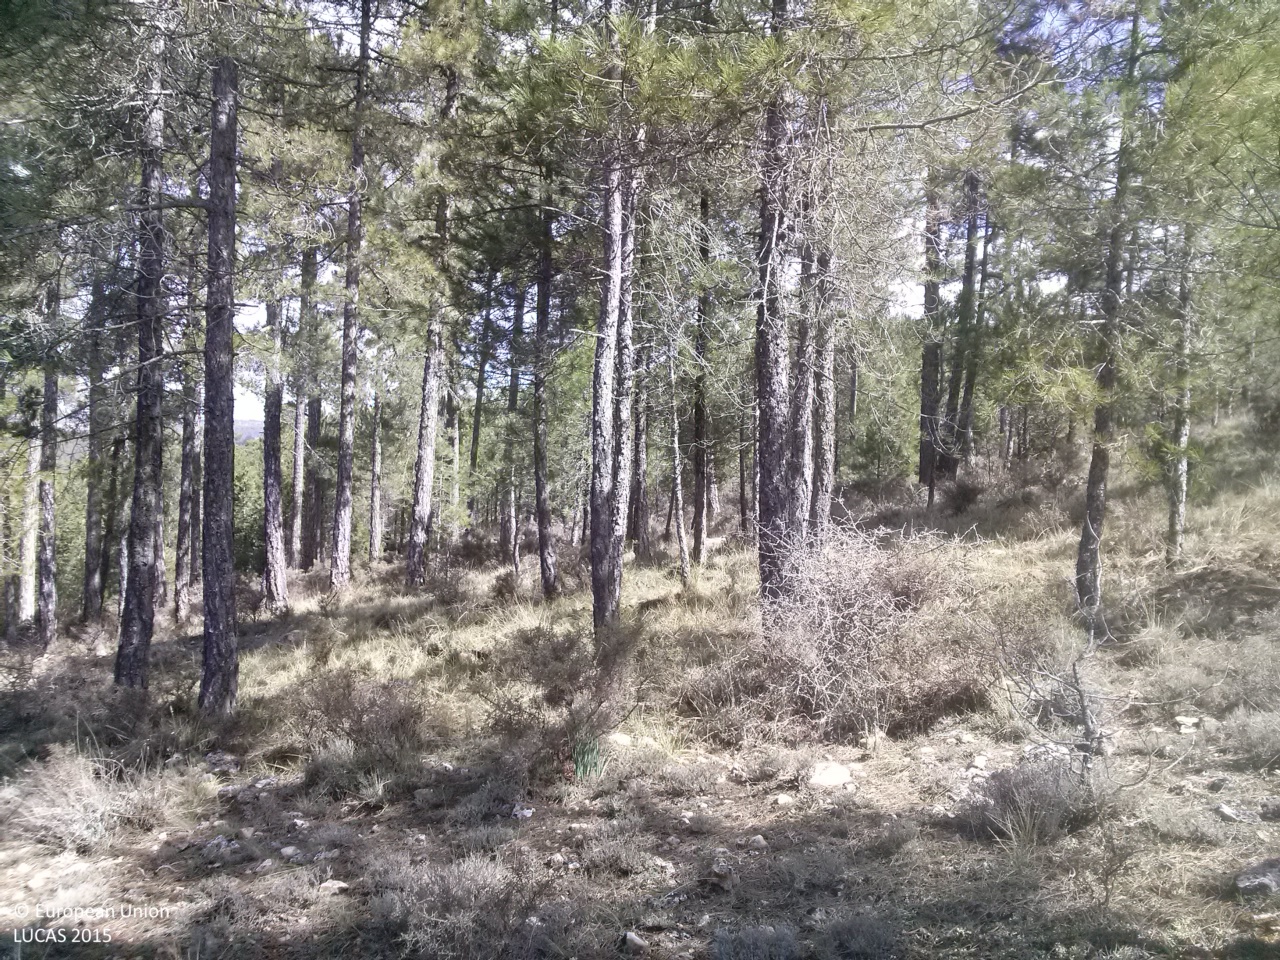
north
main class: Woodland
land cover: Pine dominated coniferous woodland
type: coniferous forest of the mediterranean region
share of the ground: 25 - 50 %
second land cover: Grassland without tree/shrub cover
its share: 50 - 75 %
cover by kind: herbaceous plants 50 %, coniferous forest trees 40 %, shrubs 10 %
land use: Forestry
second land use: Agriculture (excluding fallow land and kitchen gardens)
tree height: > 5 m
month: April
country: ES
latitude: 40.2318
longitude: -1.9216
